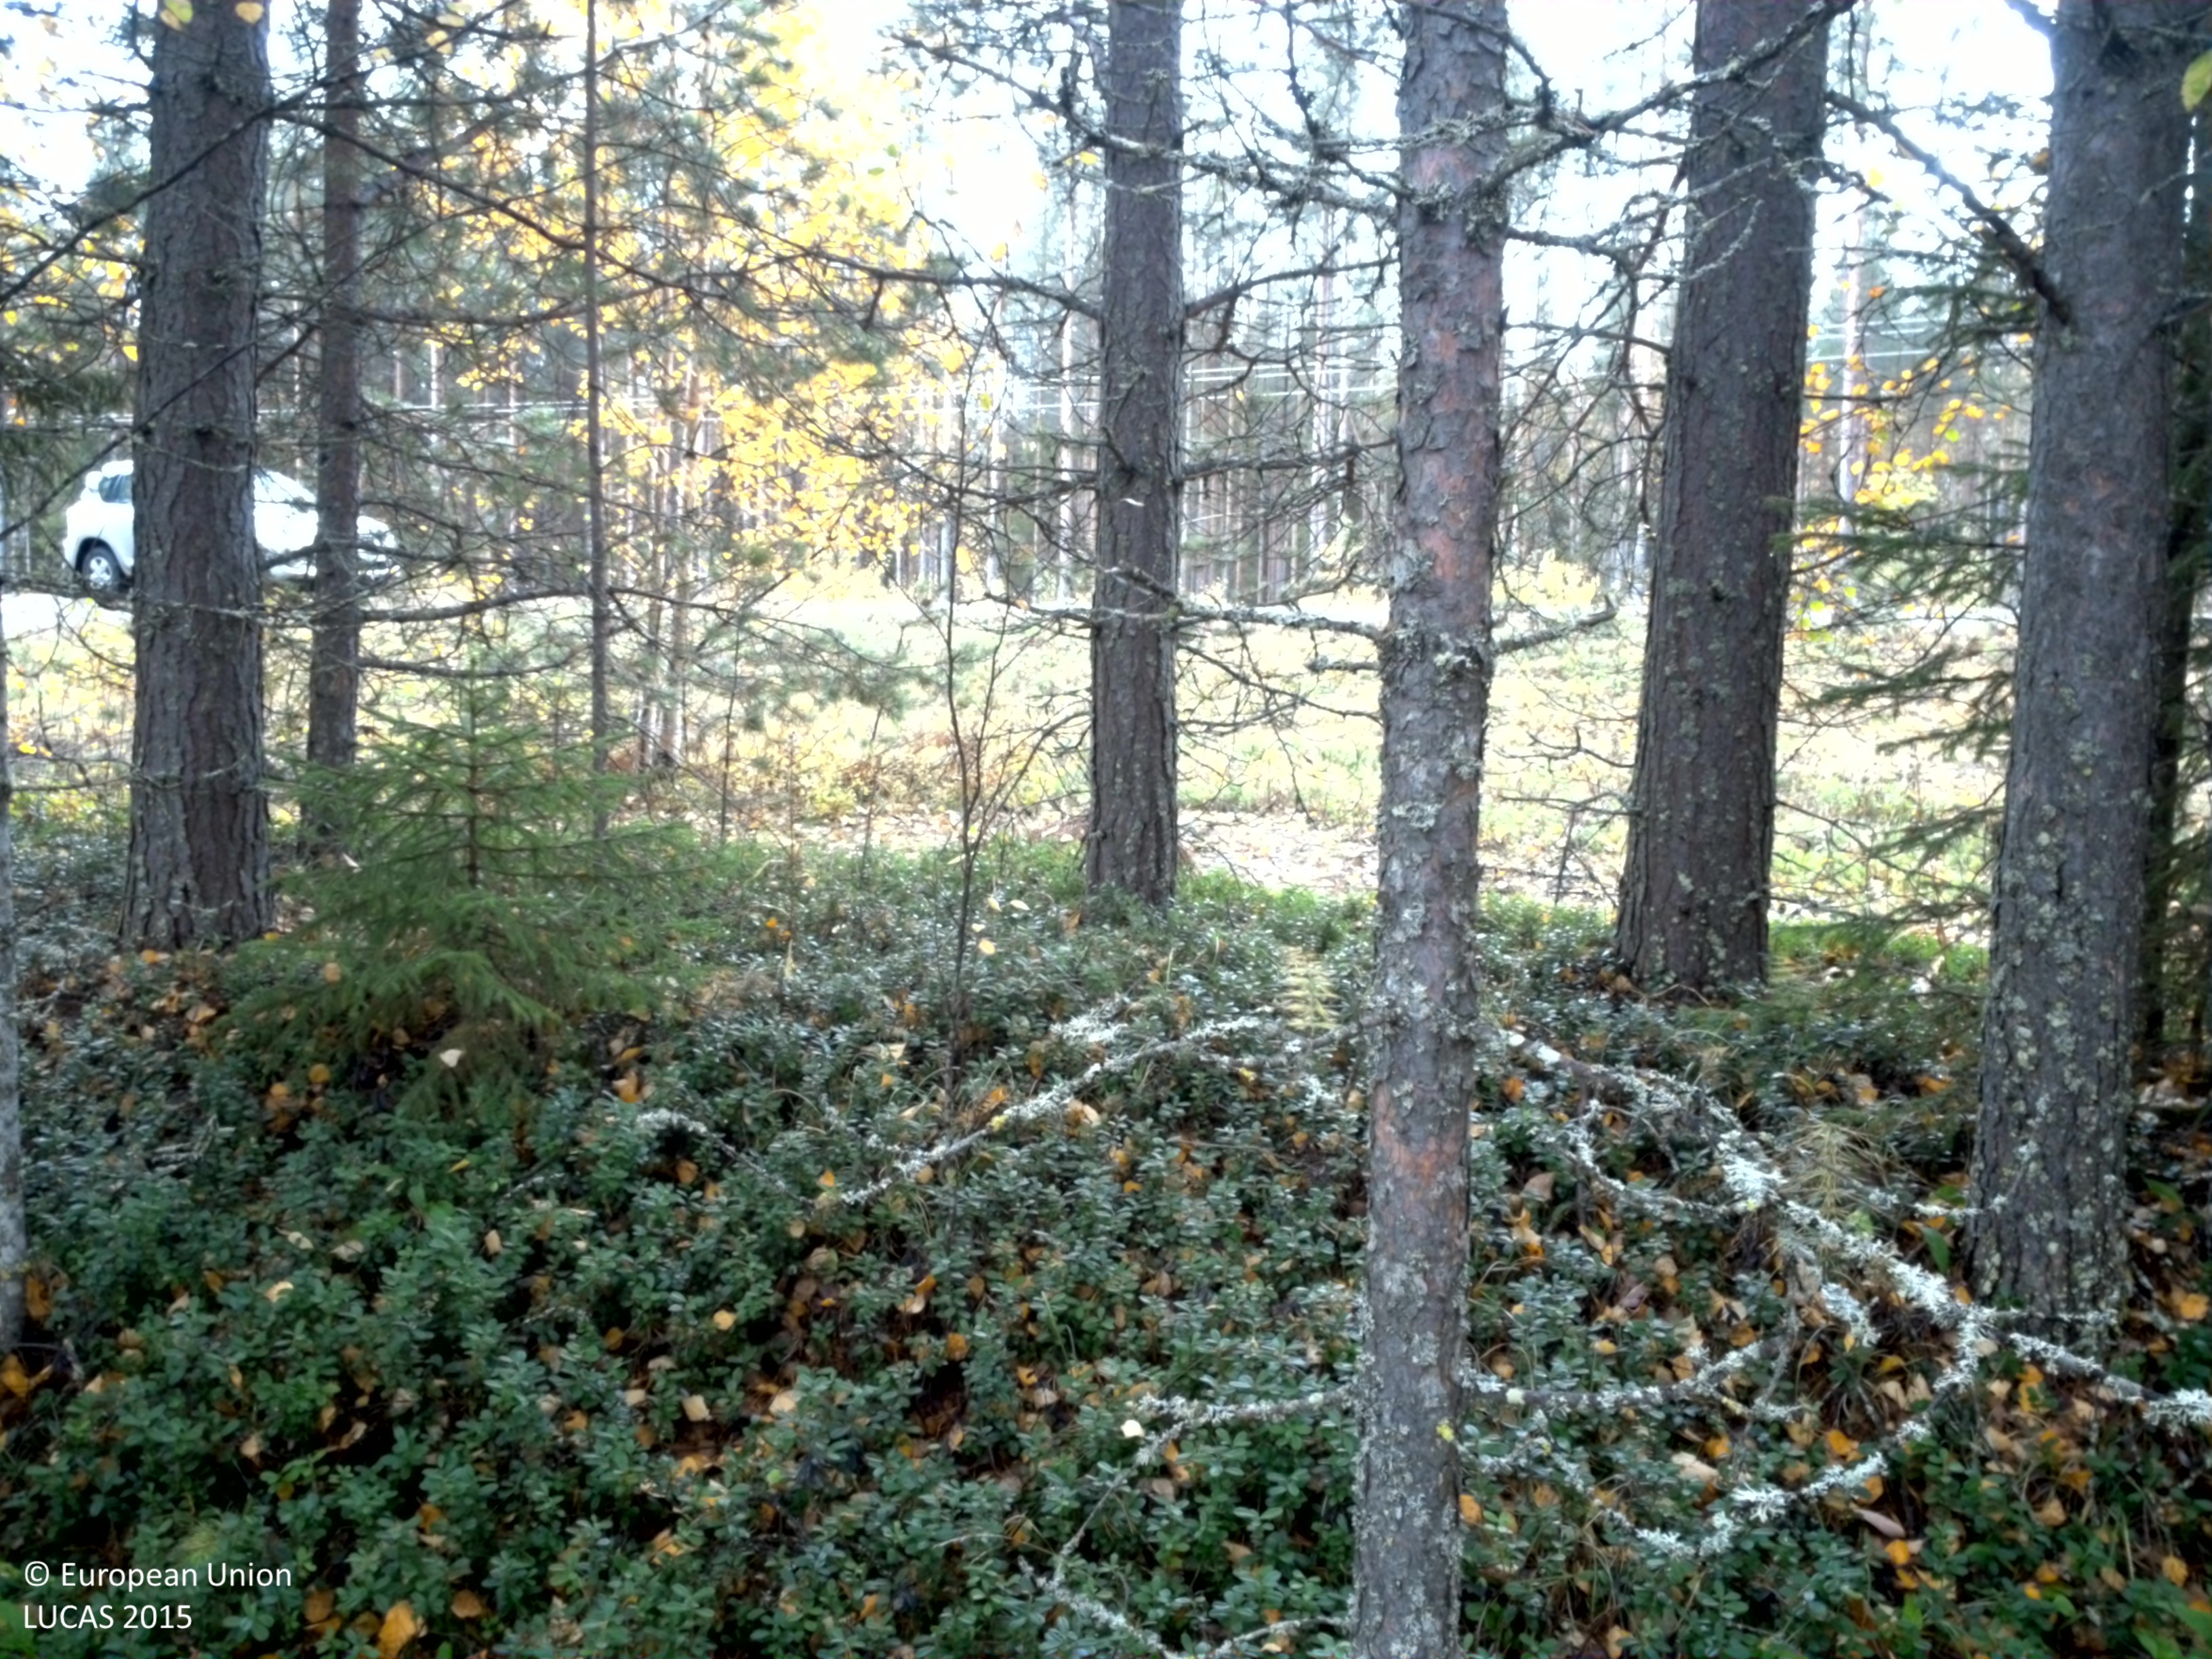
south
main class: Woodland
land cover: Pine dominated mixed woodland
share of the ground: 25 - 50 %
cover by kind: herbaceous plants 35 %, coniferous forest trees 25 %, shrubs 25 %, broadleaved forest trees 15 %
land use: Forestry
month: September
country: SE
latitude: 65.8479
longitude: 21.4692
